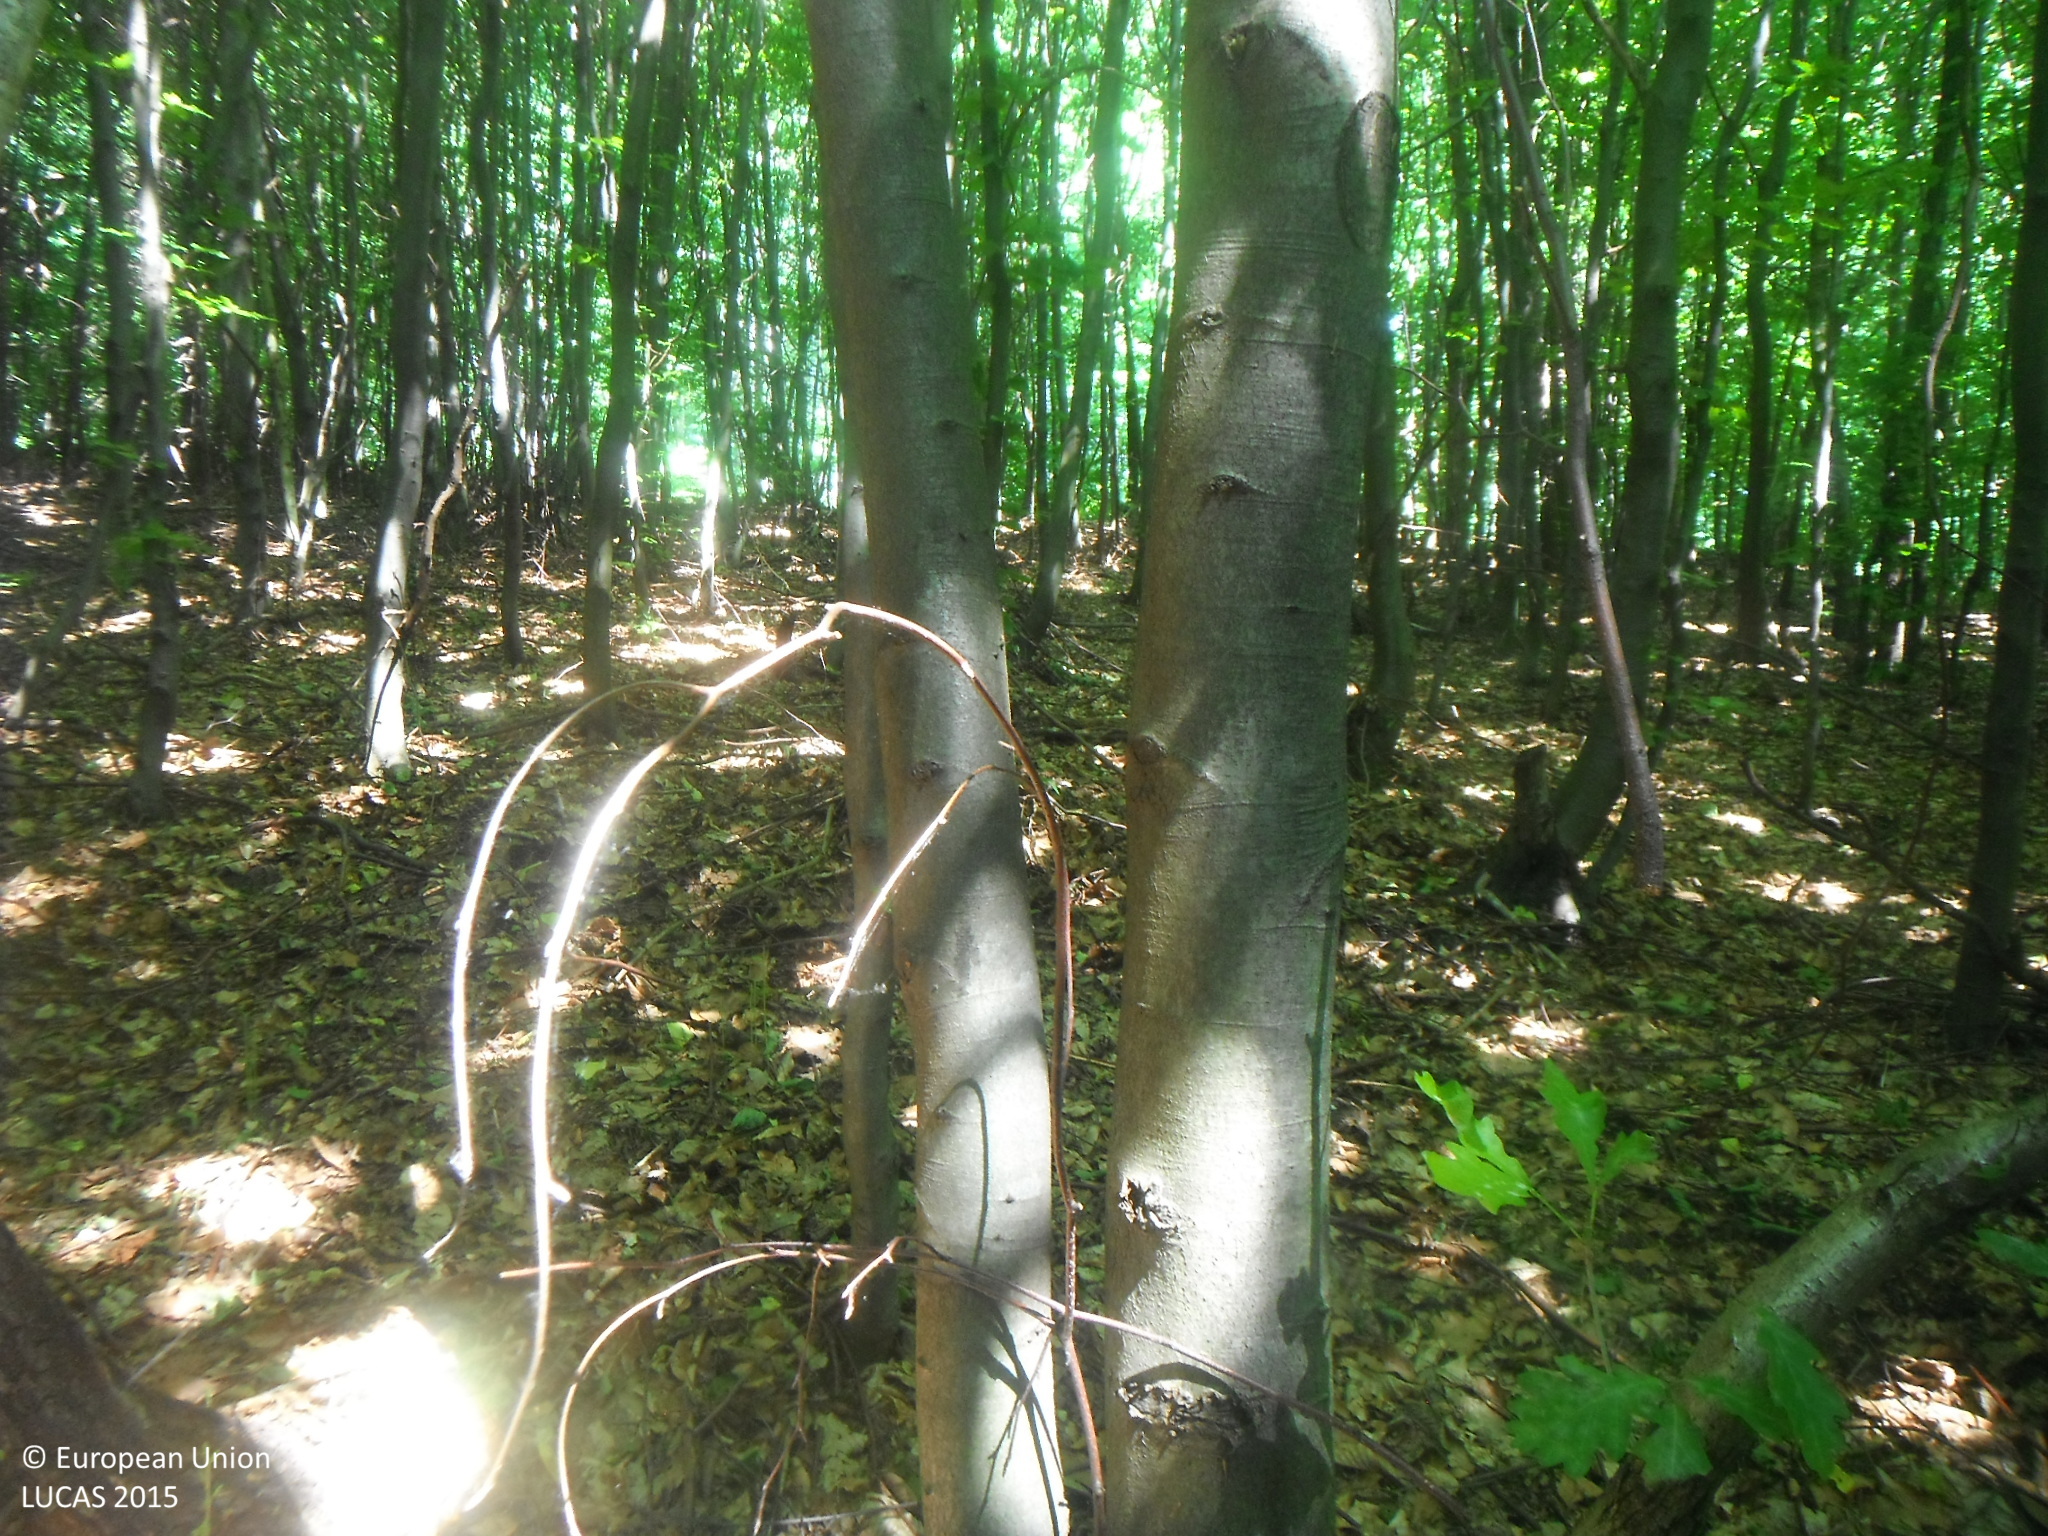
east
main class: Woodland
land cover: Broadleaved woodland
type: beech forest
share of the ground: > 75 %
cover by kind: broadleaved forest trees 95 %, herbaceous plants 5 %
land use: Forestry
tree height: > 5 m
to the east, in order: Broadleaved woodland; Tracks; Broadleaved woodland; Tracks; Broadleaved woodland
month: June
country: SK
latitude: 49.0287
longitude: 21.5790
